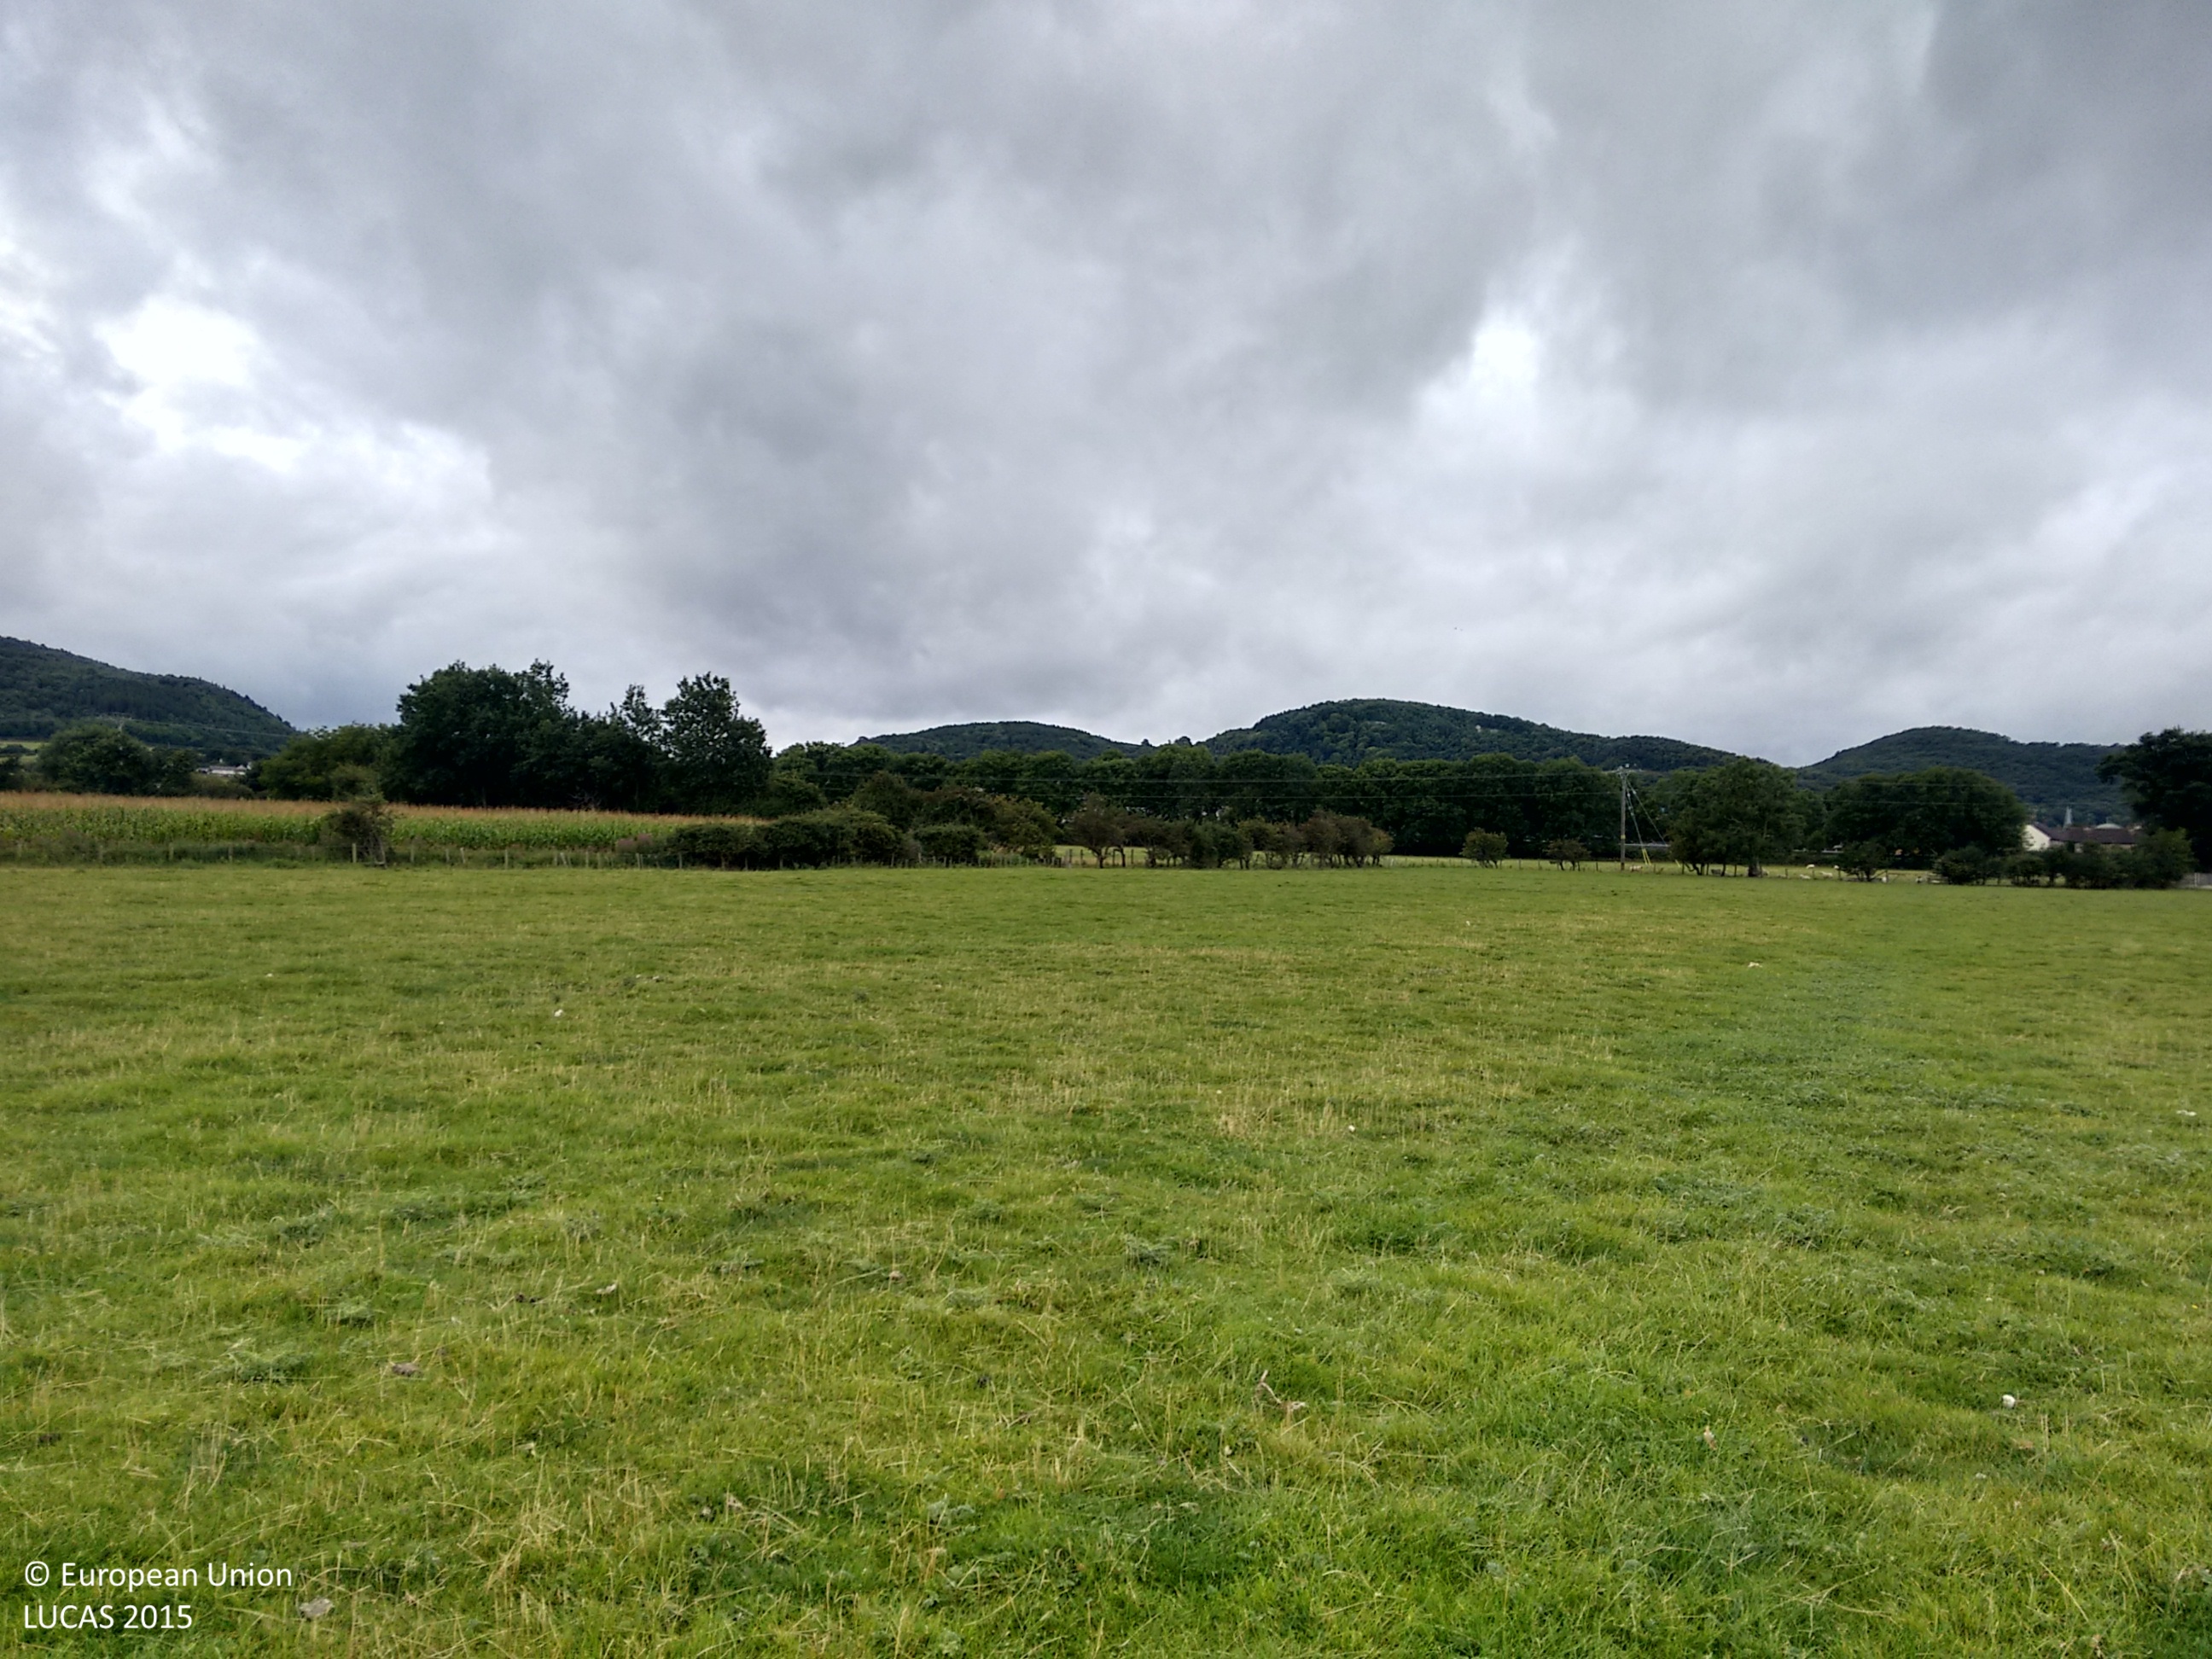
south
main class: Grassland
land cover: Grassland without tree/shrub cover
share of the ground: > 75 %
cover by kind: herbaceous plants 100 %
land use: Agriculture (excluding fallow land and kitchen gardens)
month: August
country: GB
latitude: 53.2900
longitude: -3.5715
